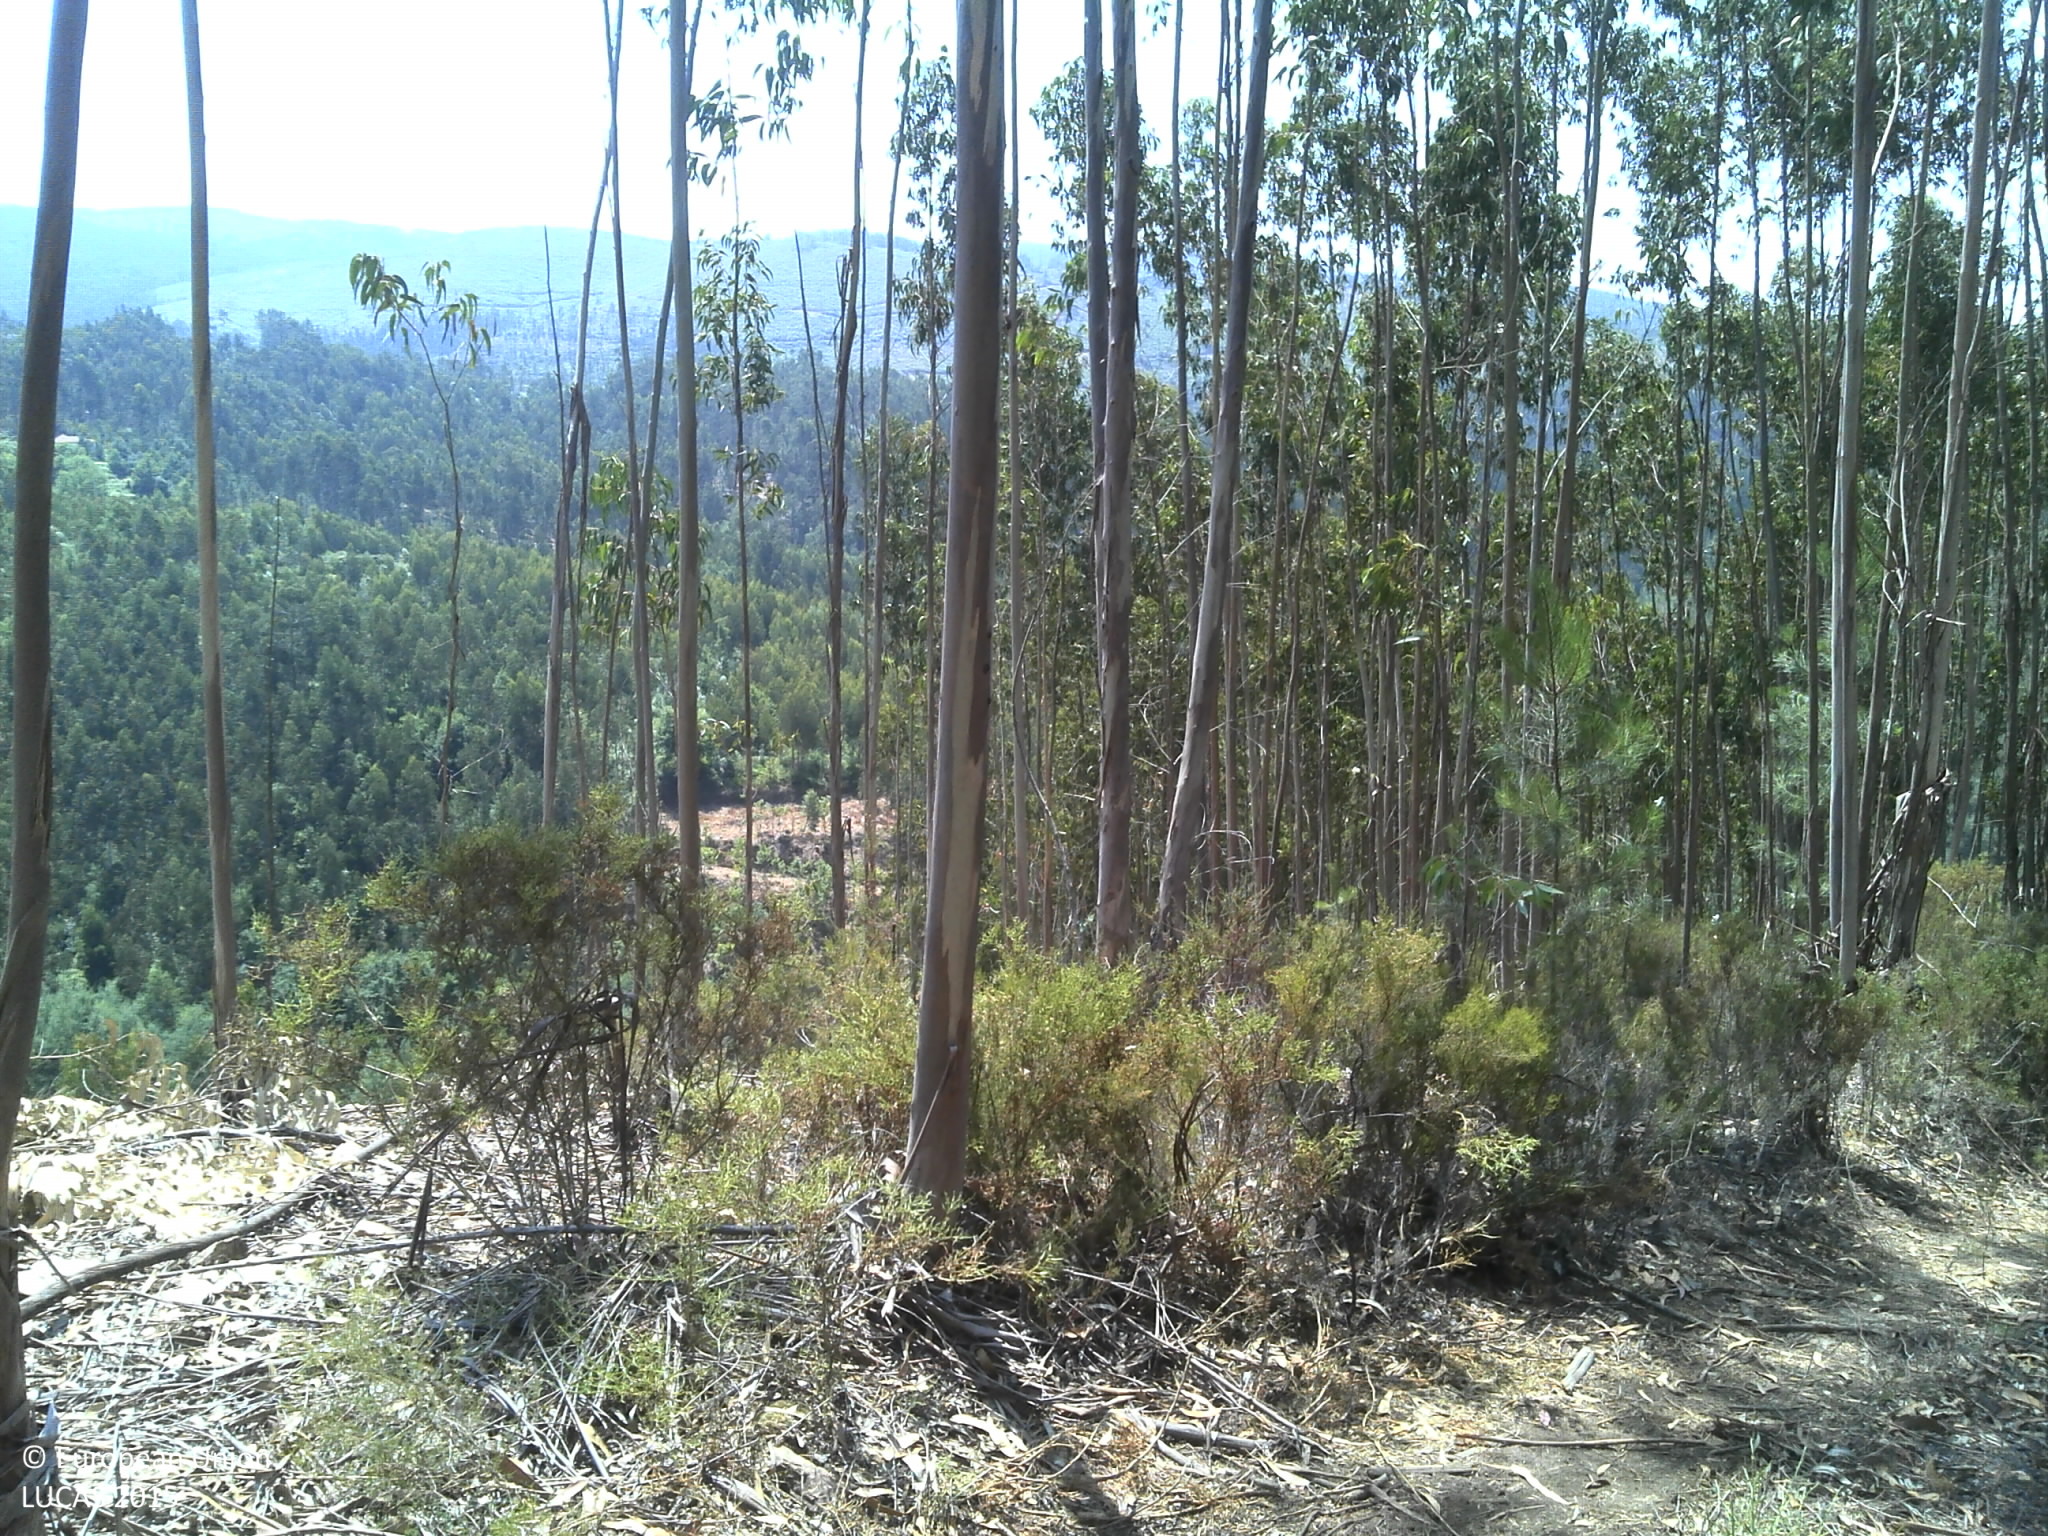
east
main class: Woodland
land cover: Broadleaved woodland
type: exotic forest
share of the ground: 50 - 75 %
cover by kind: broadleaved forest trees 70 %, shrubs 25 %, unconsolidated bare surface 5 %
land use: Forestry
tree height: > 5 m
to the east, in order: Broadleaved woodland; Shrubland without tree cover; Broadleaved woodland
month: July
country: PT
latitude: 40.6270
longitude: -8.3539
